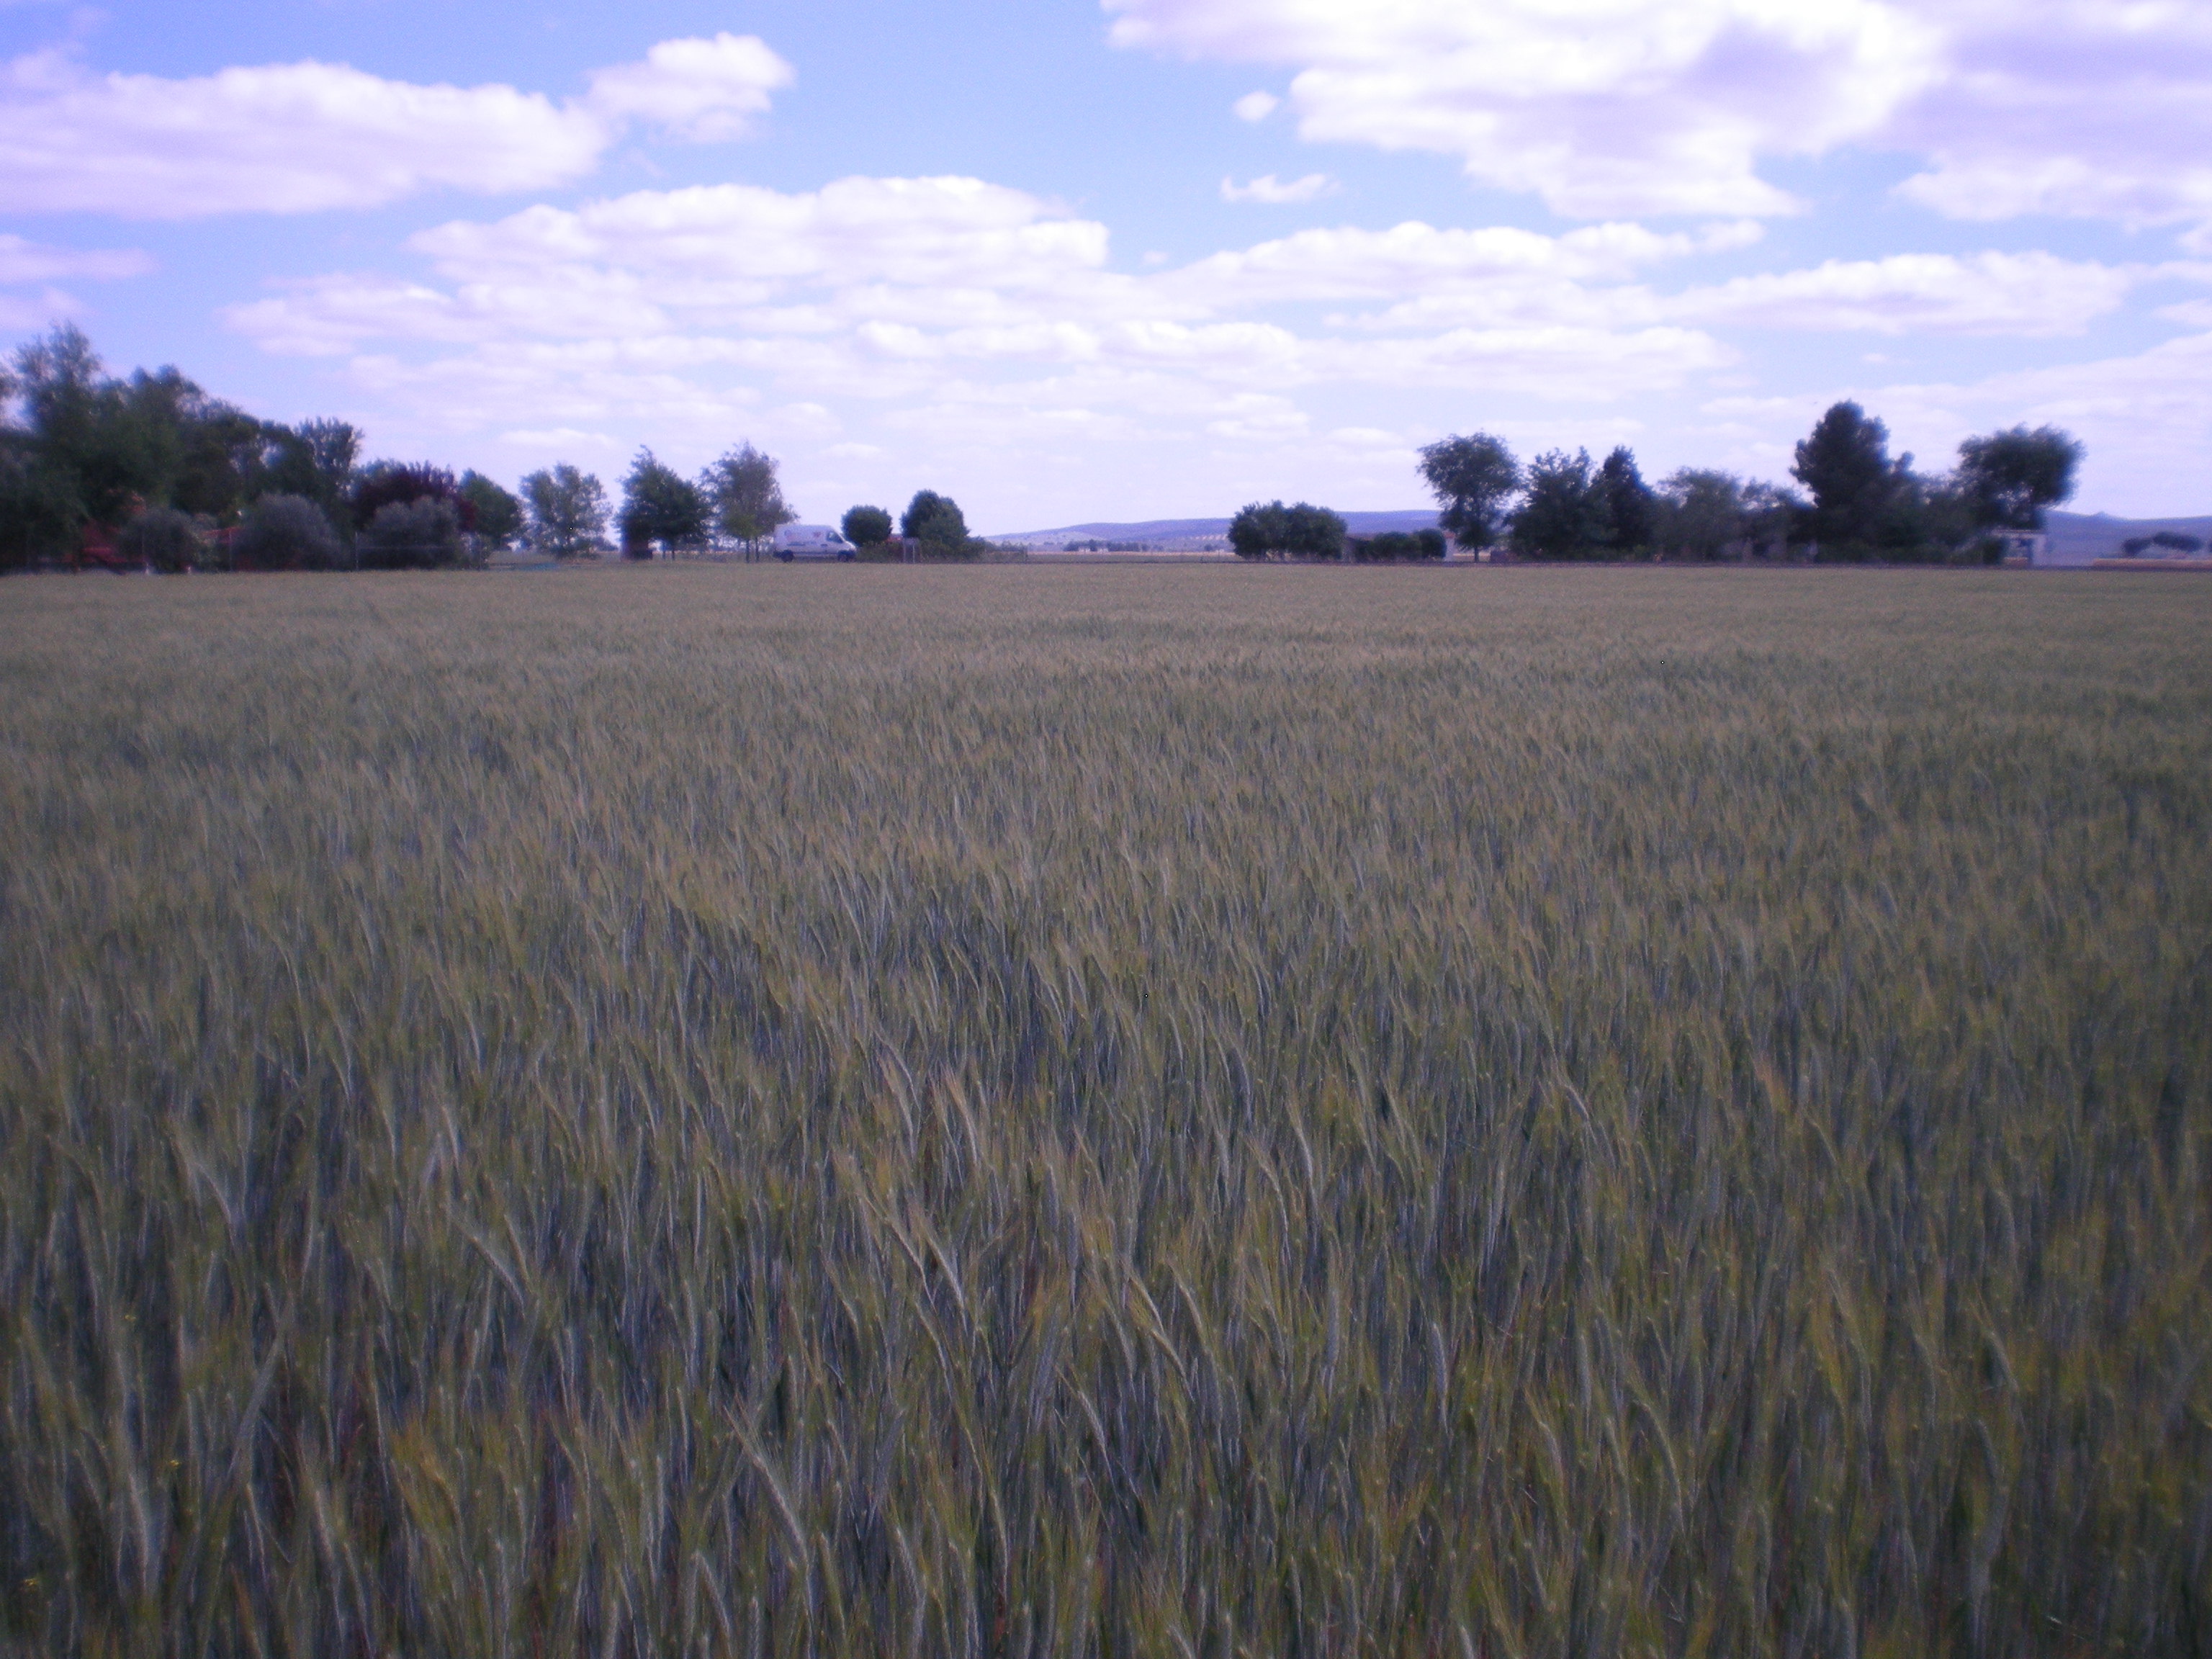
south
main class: Cropland
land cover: Durum wheat
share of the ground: > 75 %
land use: Agriculture (excluding fallow land and kitchen gardens)
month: May
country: ES
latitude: 38.9686
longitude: -3.4607
